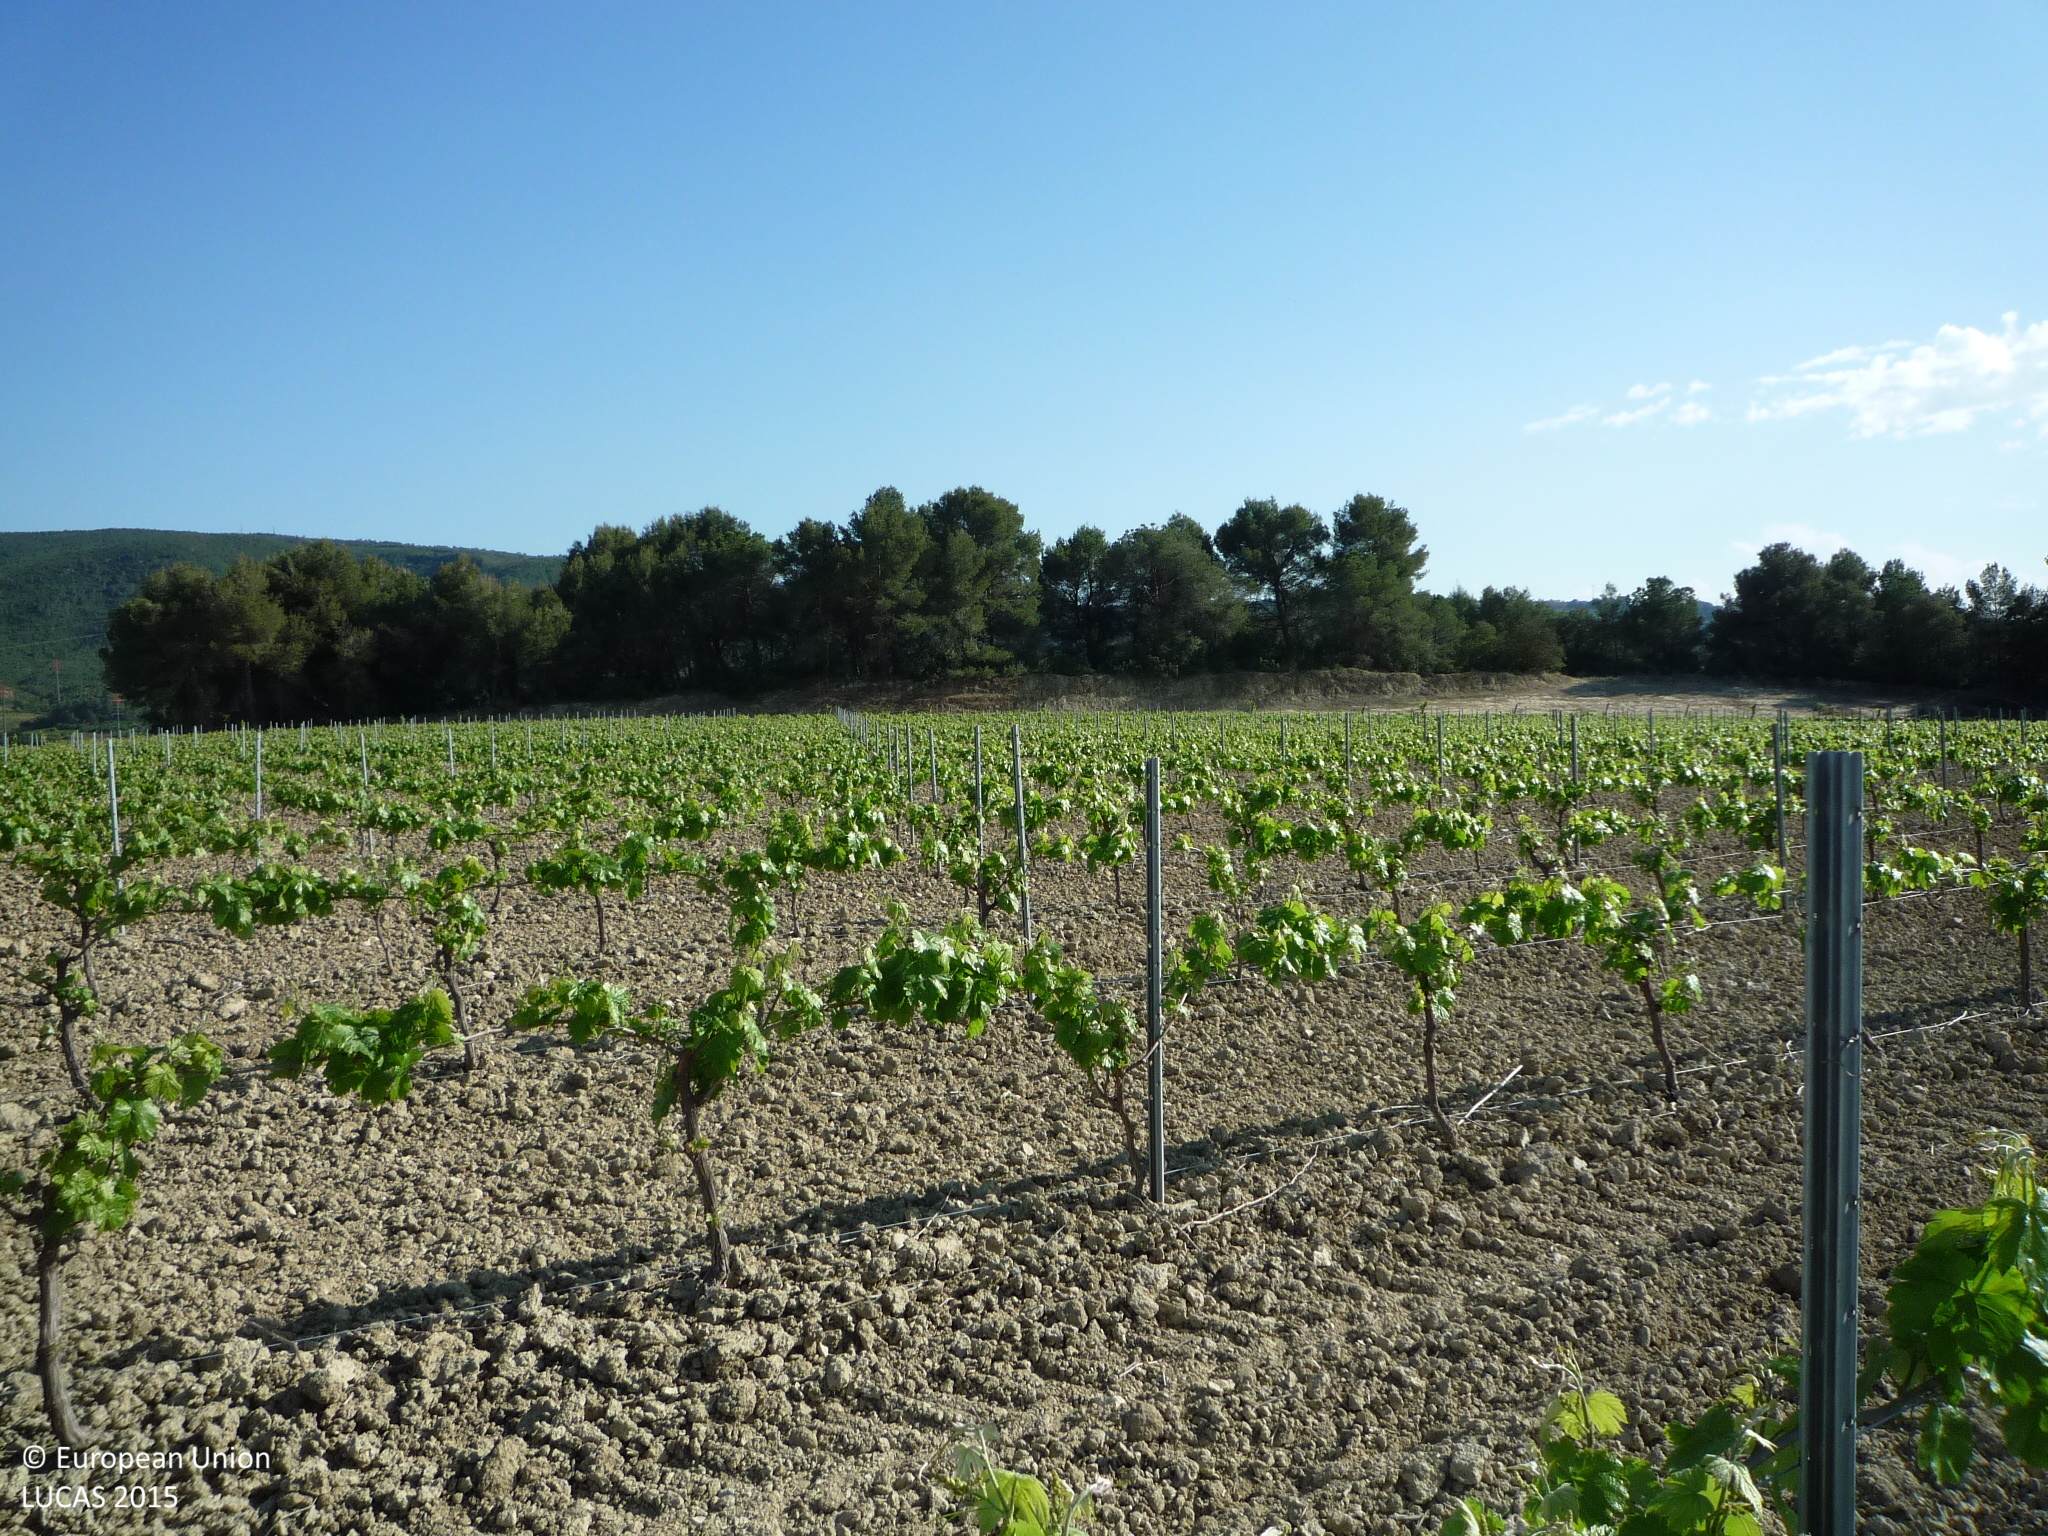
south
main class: Cropland
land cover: Vineyards
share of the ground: 10 - 25 %
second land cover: Other bare soil
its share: > 75 %
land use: Agriculture (excluding fallow land and kitchen gardens)
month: April
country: ES
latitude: 41.4333
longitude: 1.8196
